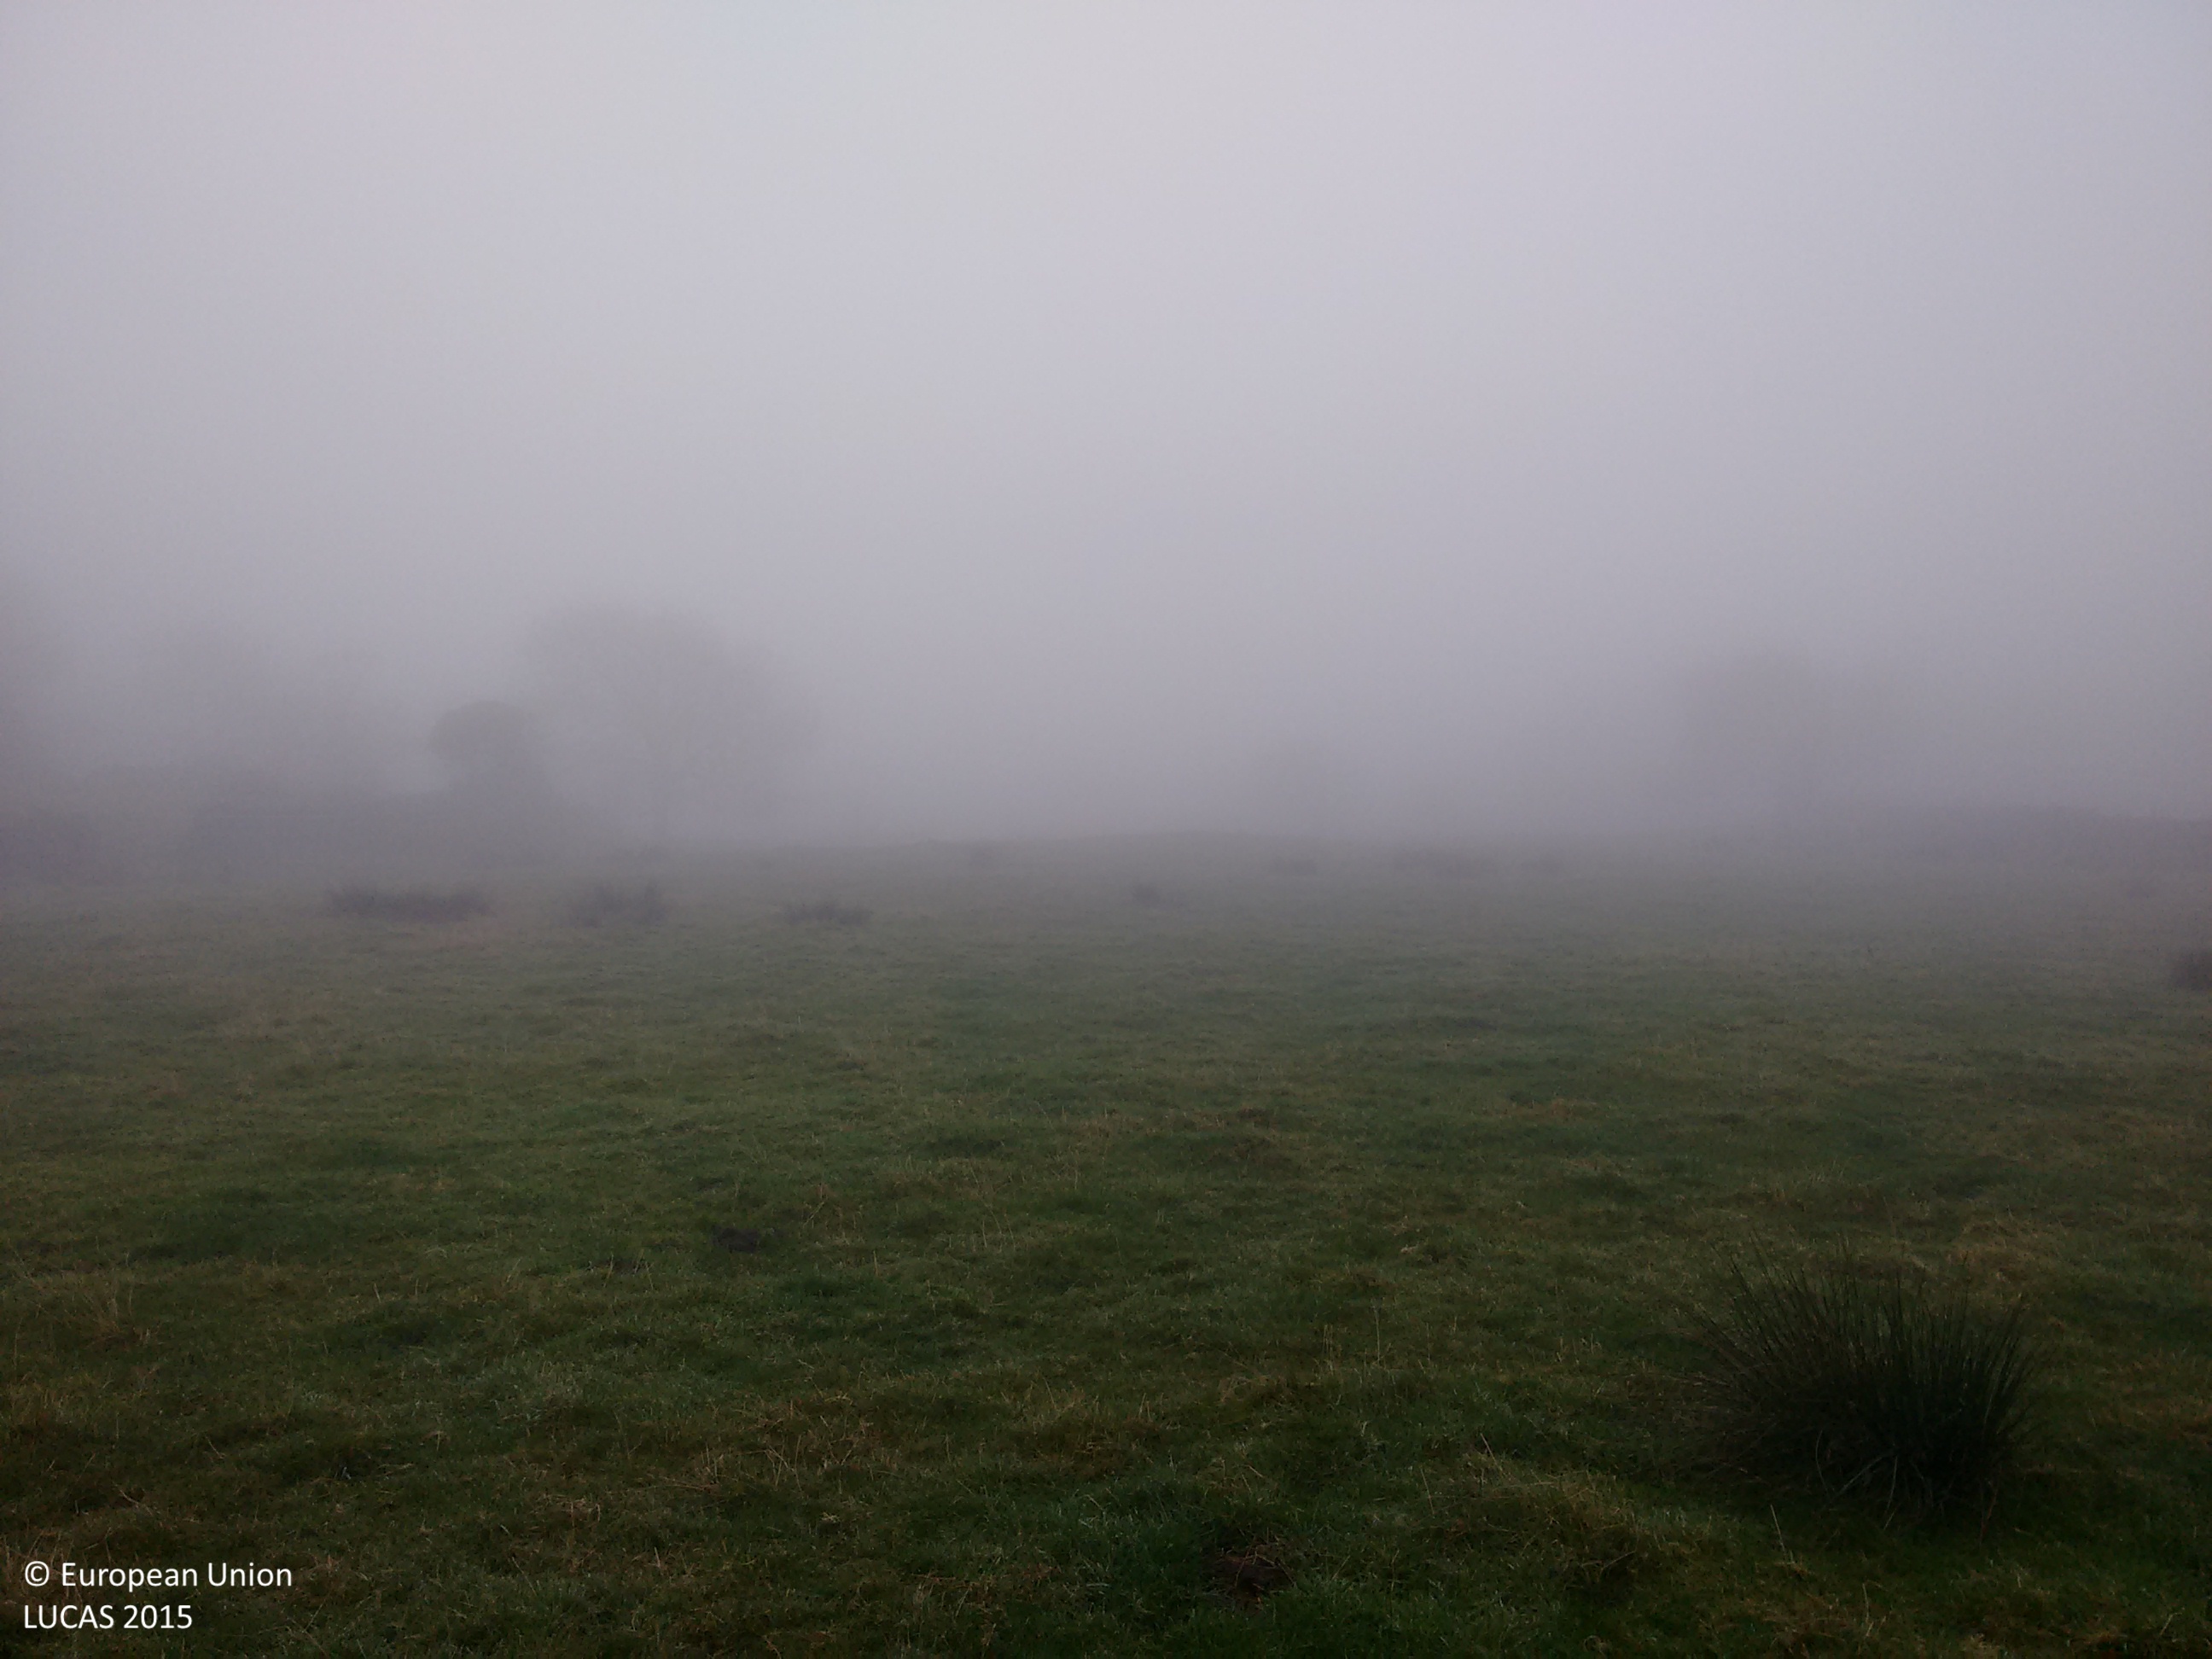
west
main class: Grassland
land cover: Grassland without tree/shrub cover
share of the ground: > 75 %
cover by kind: herbaceous plants 100 %
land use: Agriculture (excluding fallow land and kitchen gardens)
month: November
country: GB
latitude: 54.2357
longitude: -3.1006
